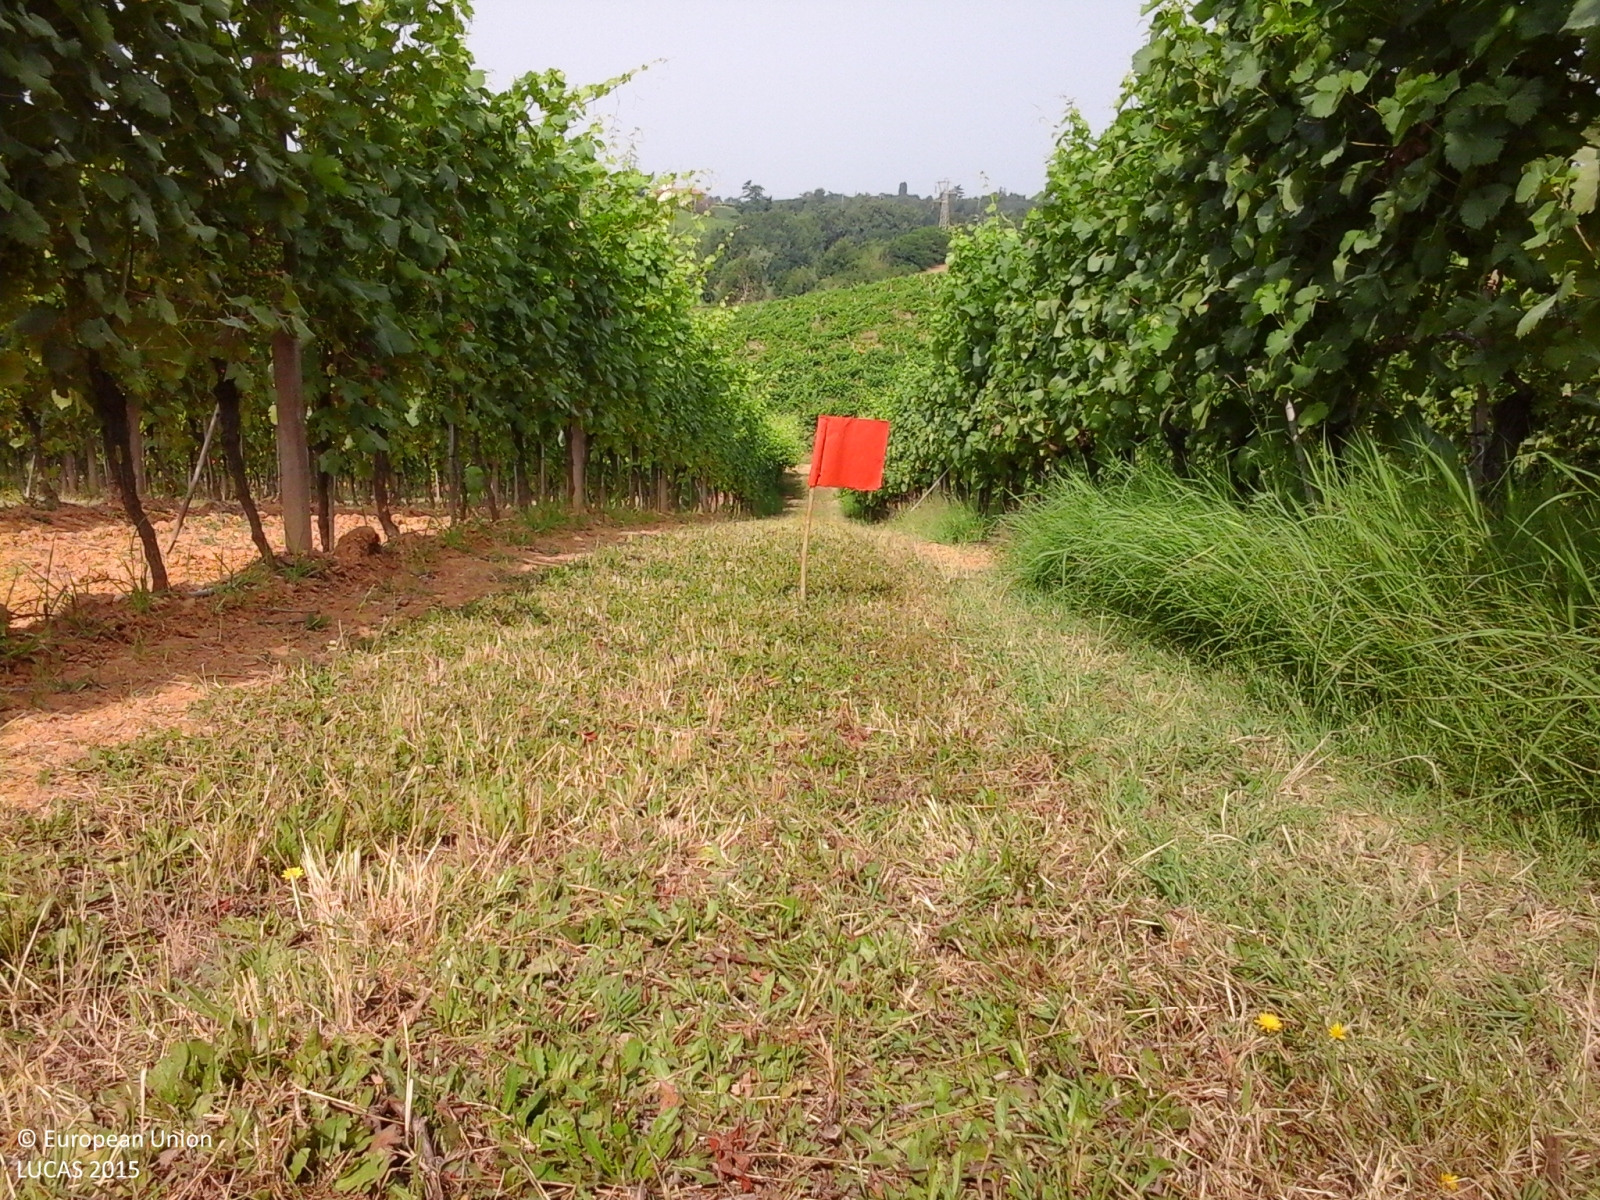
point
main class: Cropland
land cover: Vineyards
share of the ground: 25 - 50 %
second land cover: Grassland without tree/shrub cover
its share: > 75 %
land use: Agriculture (excluding fallow land and kitchen gardens)
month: July
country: IT
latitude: 44.7404
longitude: 8.8027
